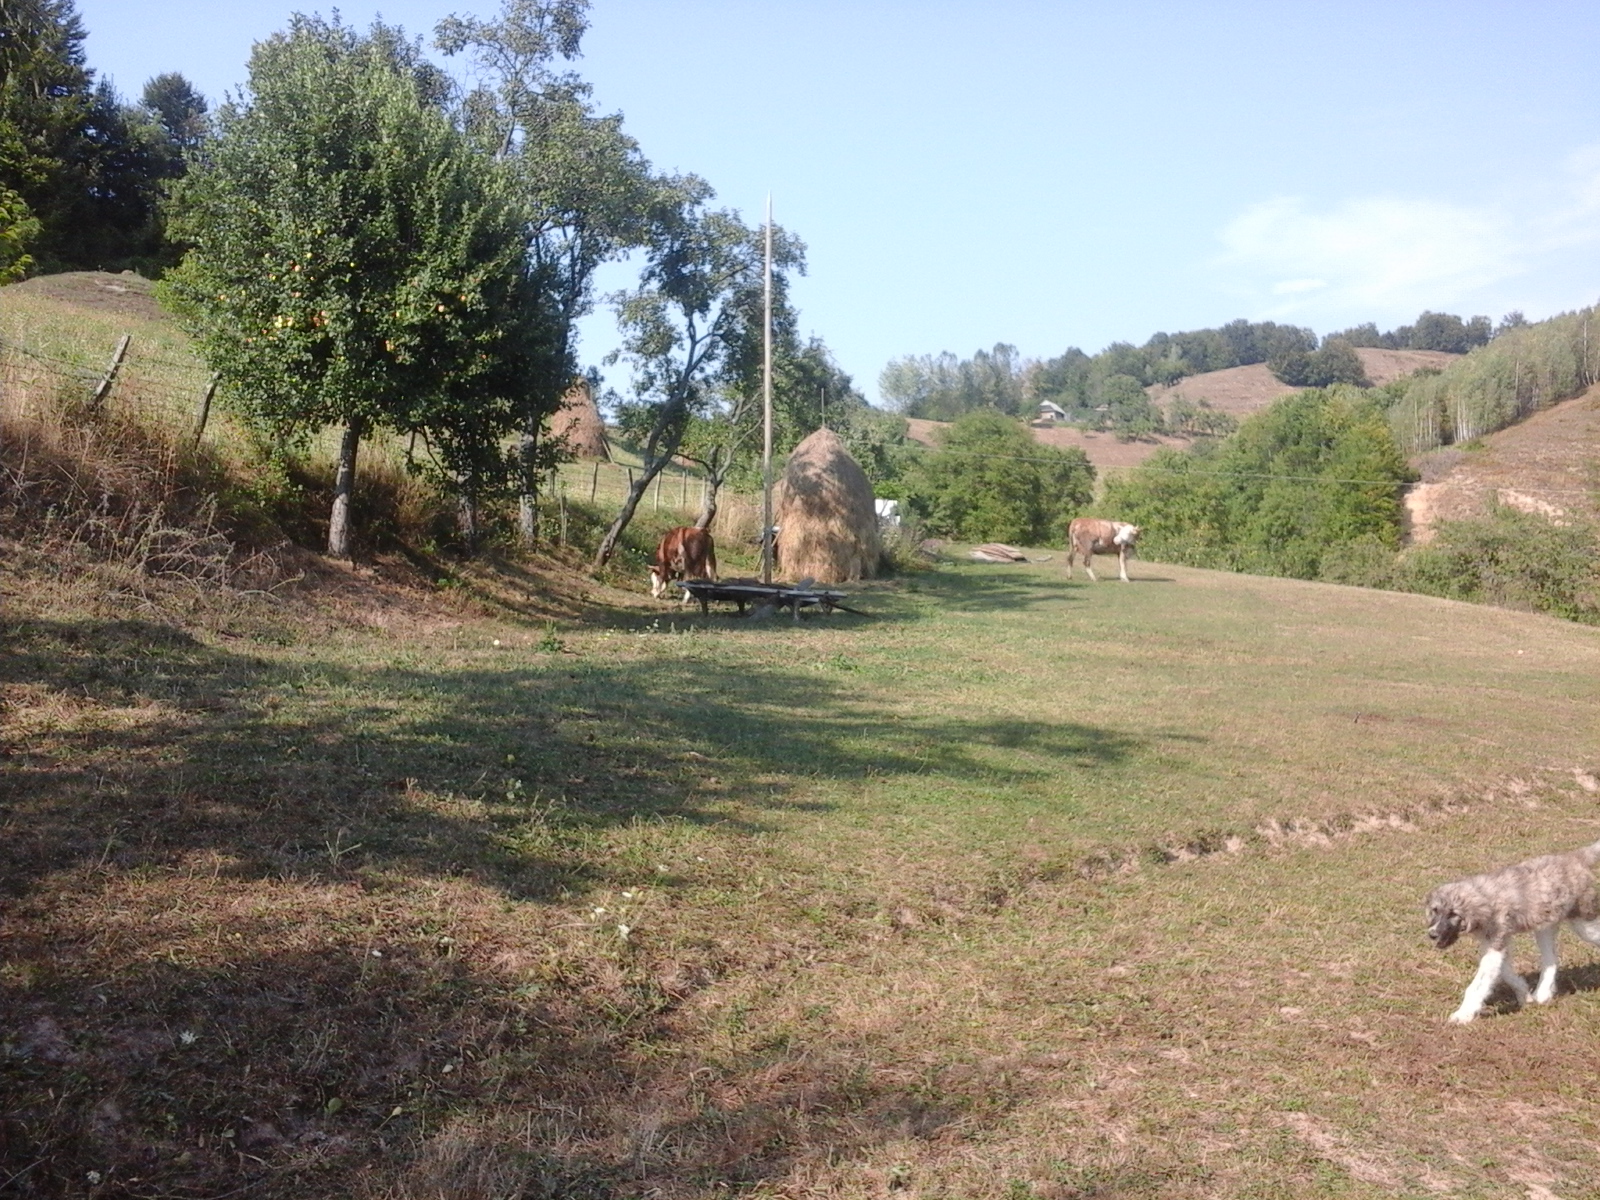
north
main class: Grassland
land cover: Grassland without tree/shrub cover
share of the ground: > 75 %
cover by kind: herbaceous plants 100 %
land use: Agriculture (excluding fallow land and kitchen gardens)
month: September
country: RO
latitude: 47.3904
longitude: 24.1953
